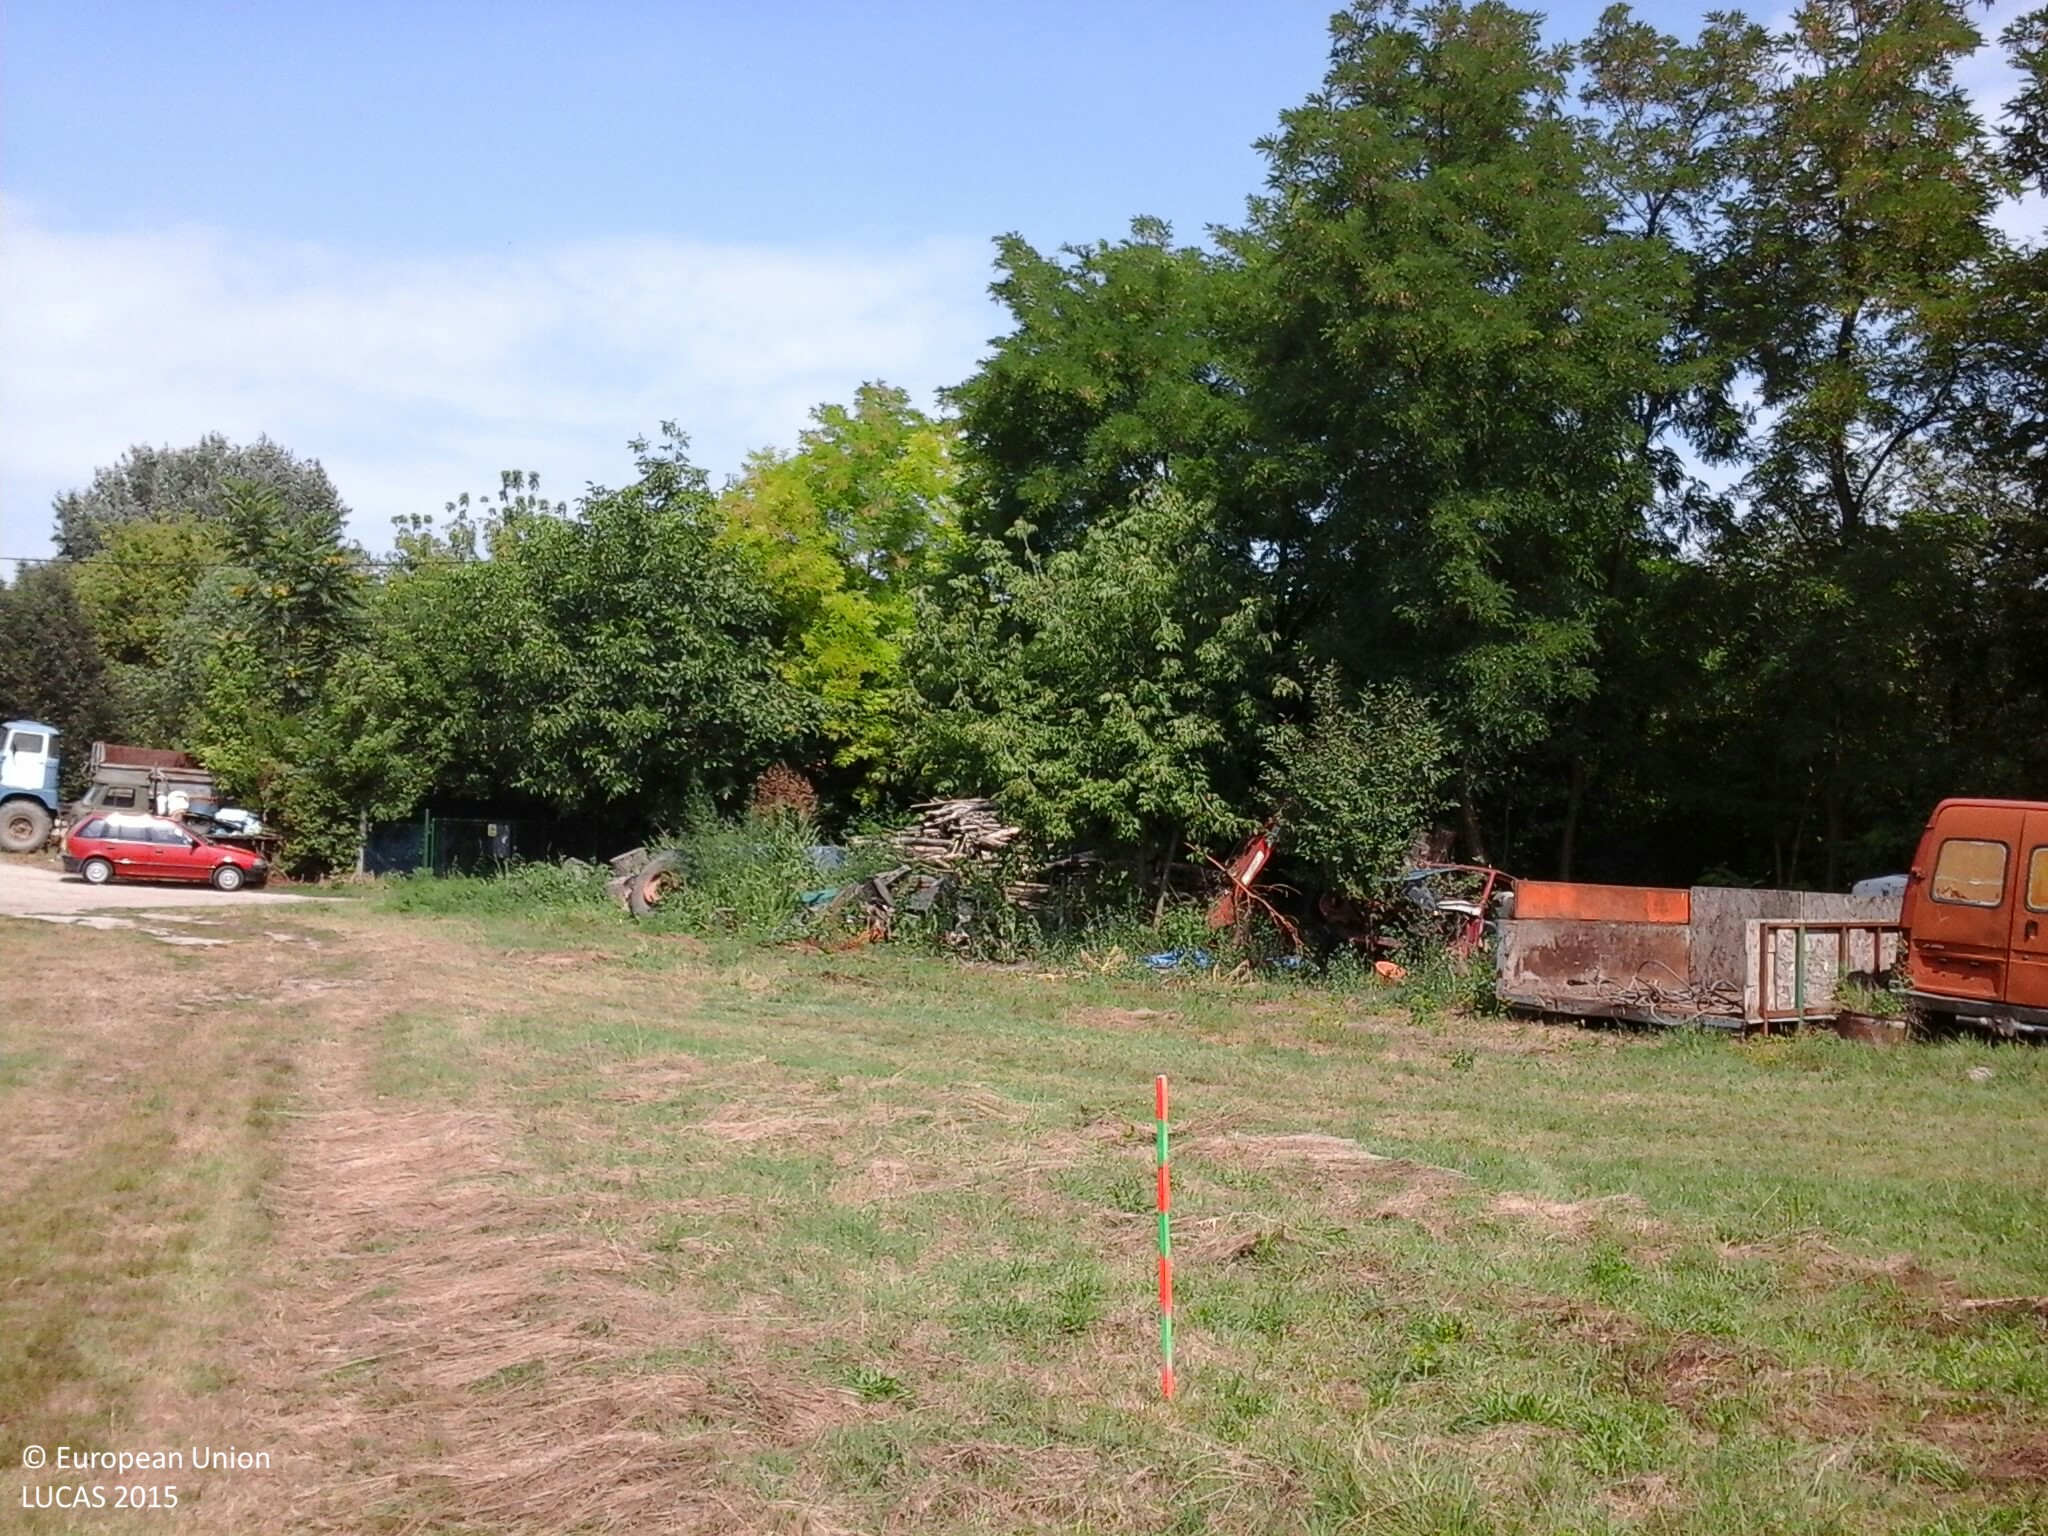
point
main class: Grassland
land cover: Grassland without tree/shrub cover
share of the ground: > 75 %
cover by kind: herbaceous plants 100 %
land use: Agriculture (excluding fallow land and kitchen gardens)
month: August
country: HU
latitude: 46.8975
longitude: 18.0554
